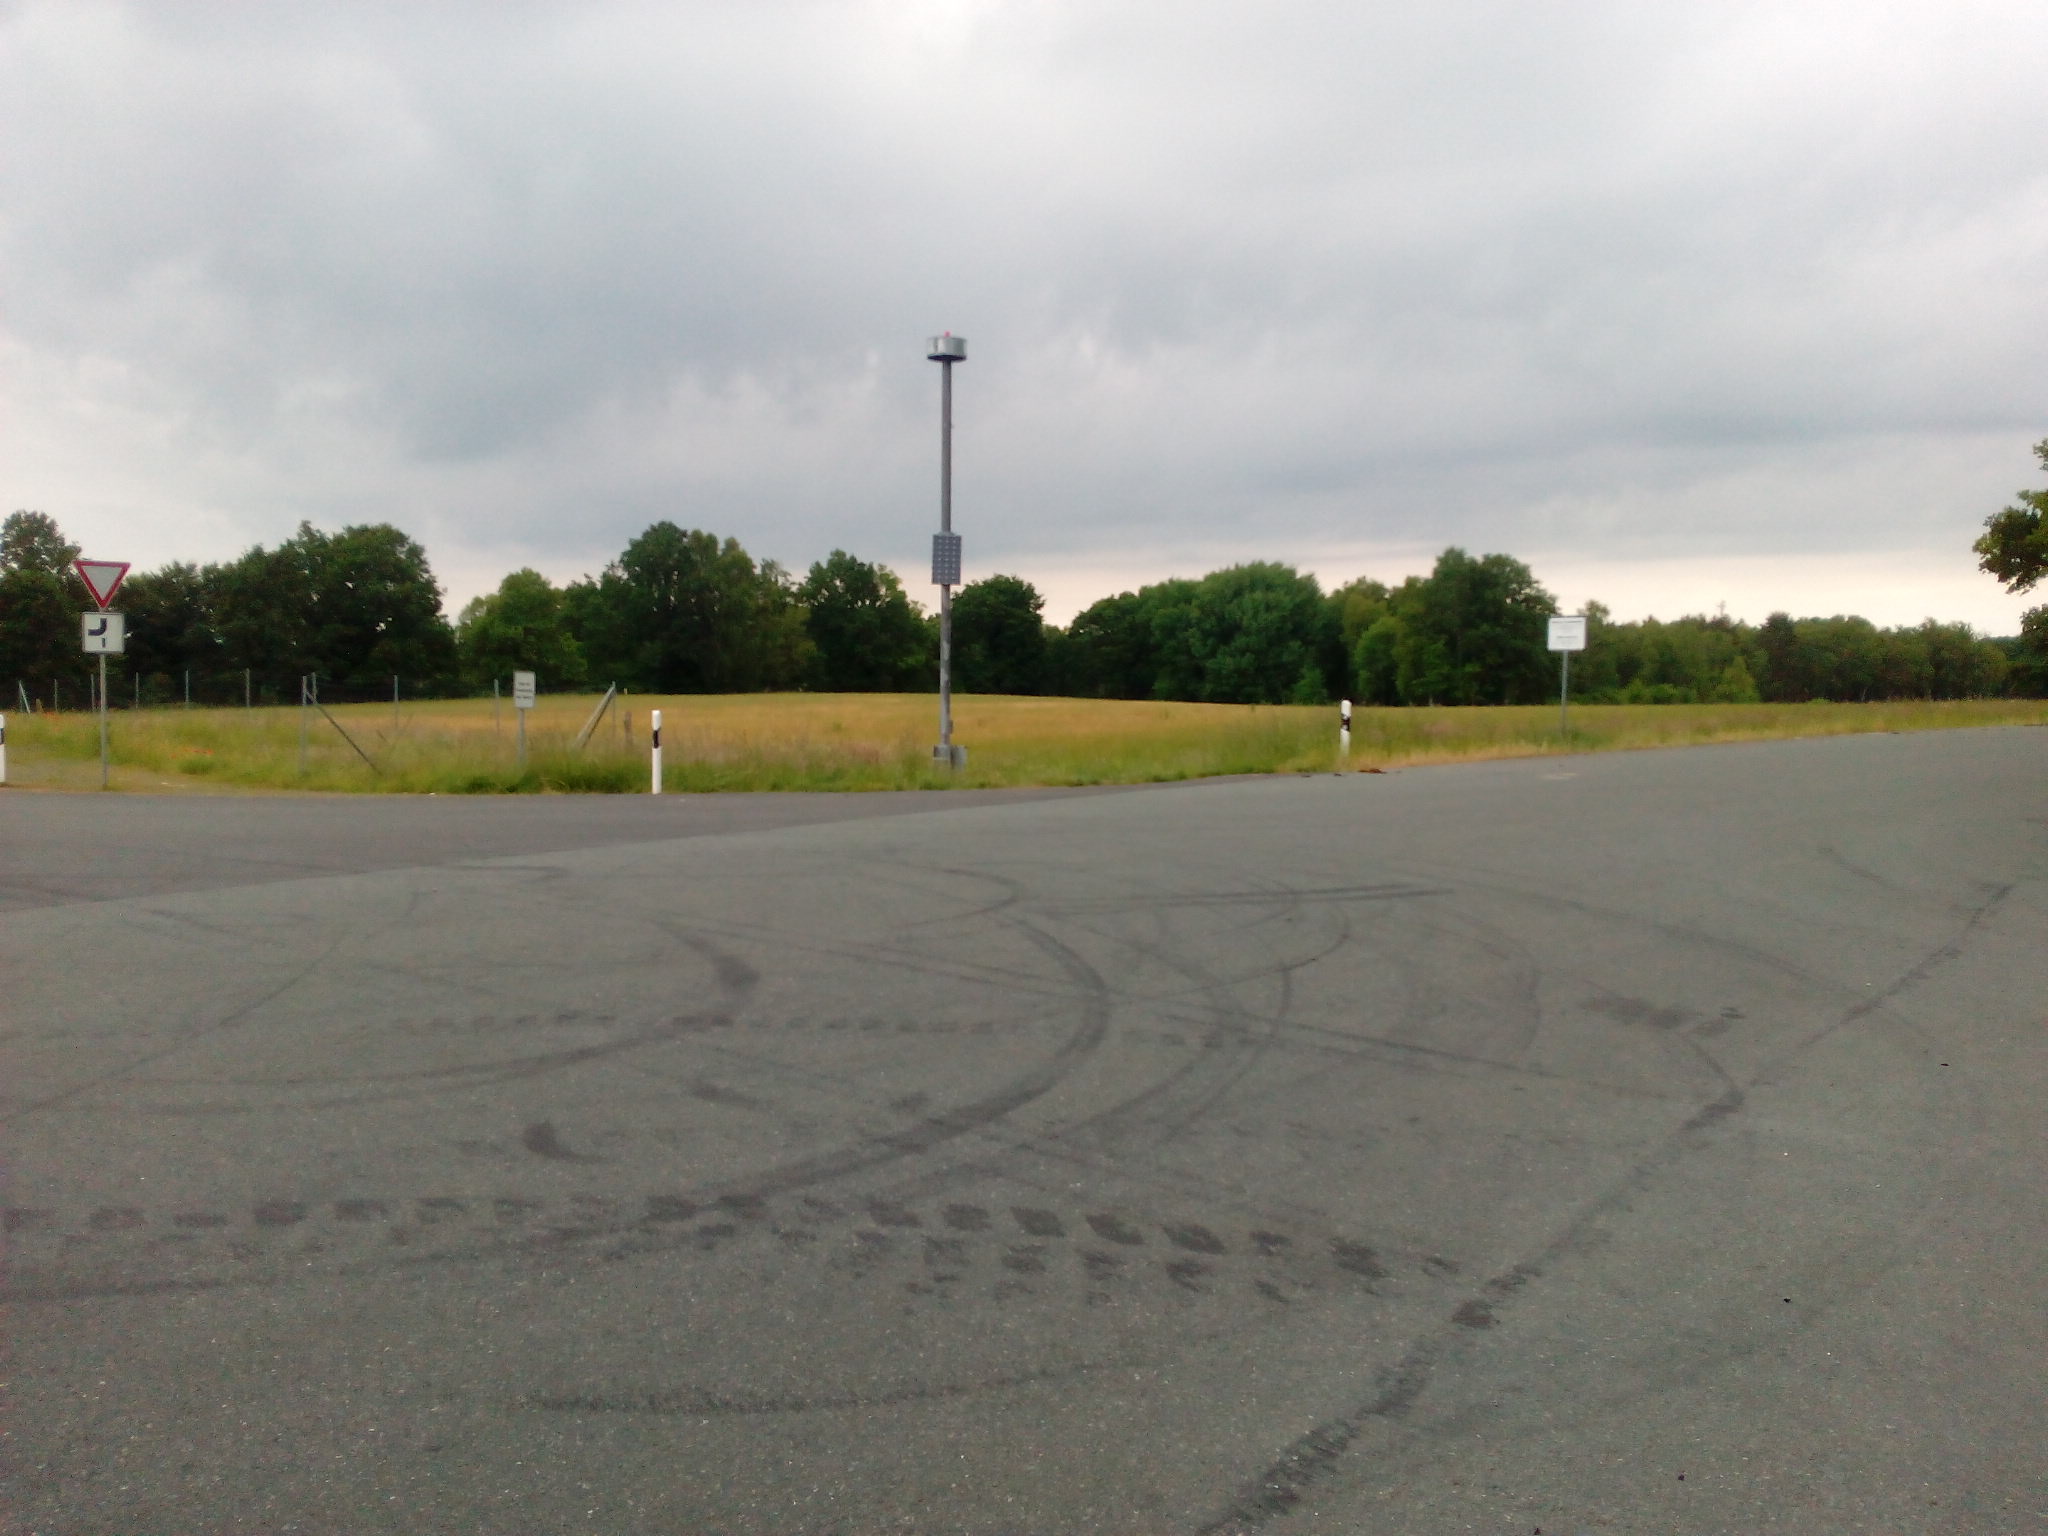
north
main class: Woodland
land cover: Pine dominated coniferous woodland
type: hemiboreal forest and nemoral coniferous forest and mixed broadleaved-coniferous forest
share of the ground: 50 - 75 %
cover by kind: coniferous forest trees 75 %, herbaceous plants 25 %
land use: Community services
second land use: Forestry
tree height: > 5 m
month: June
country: DE
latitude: 52.8806
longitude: 9.8663
